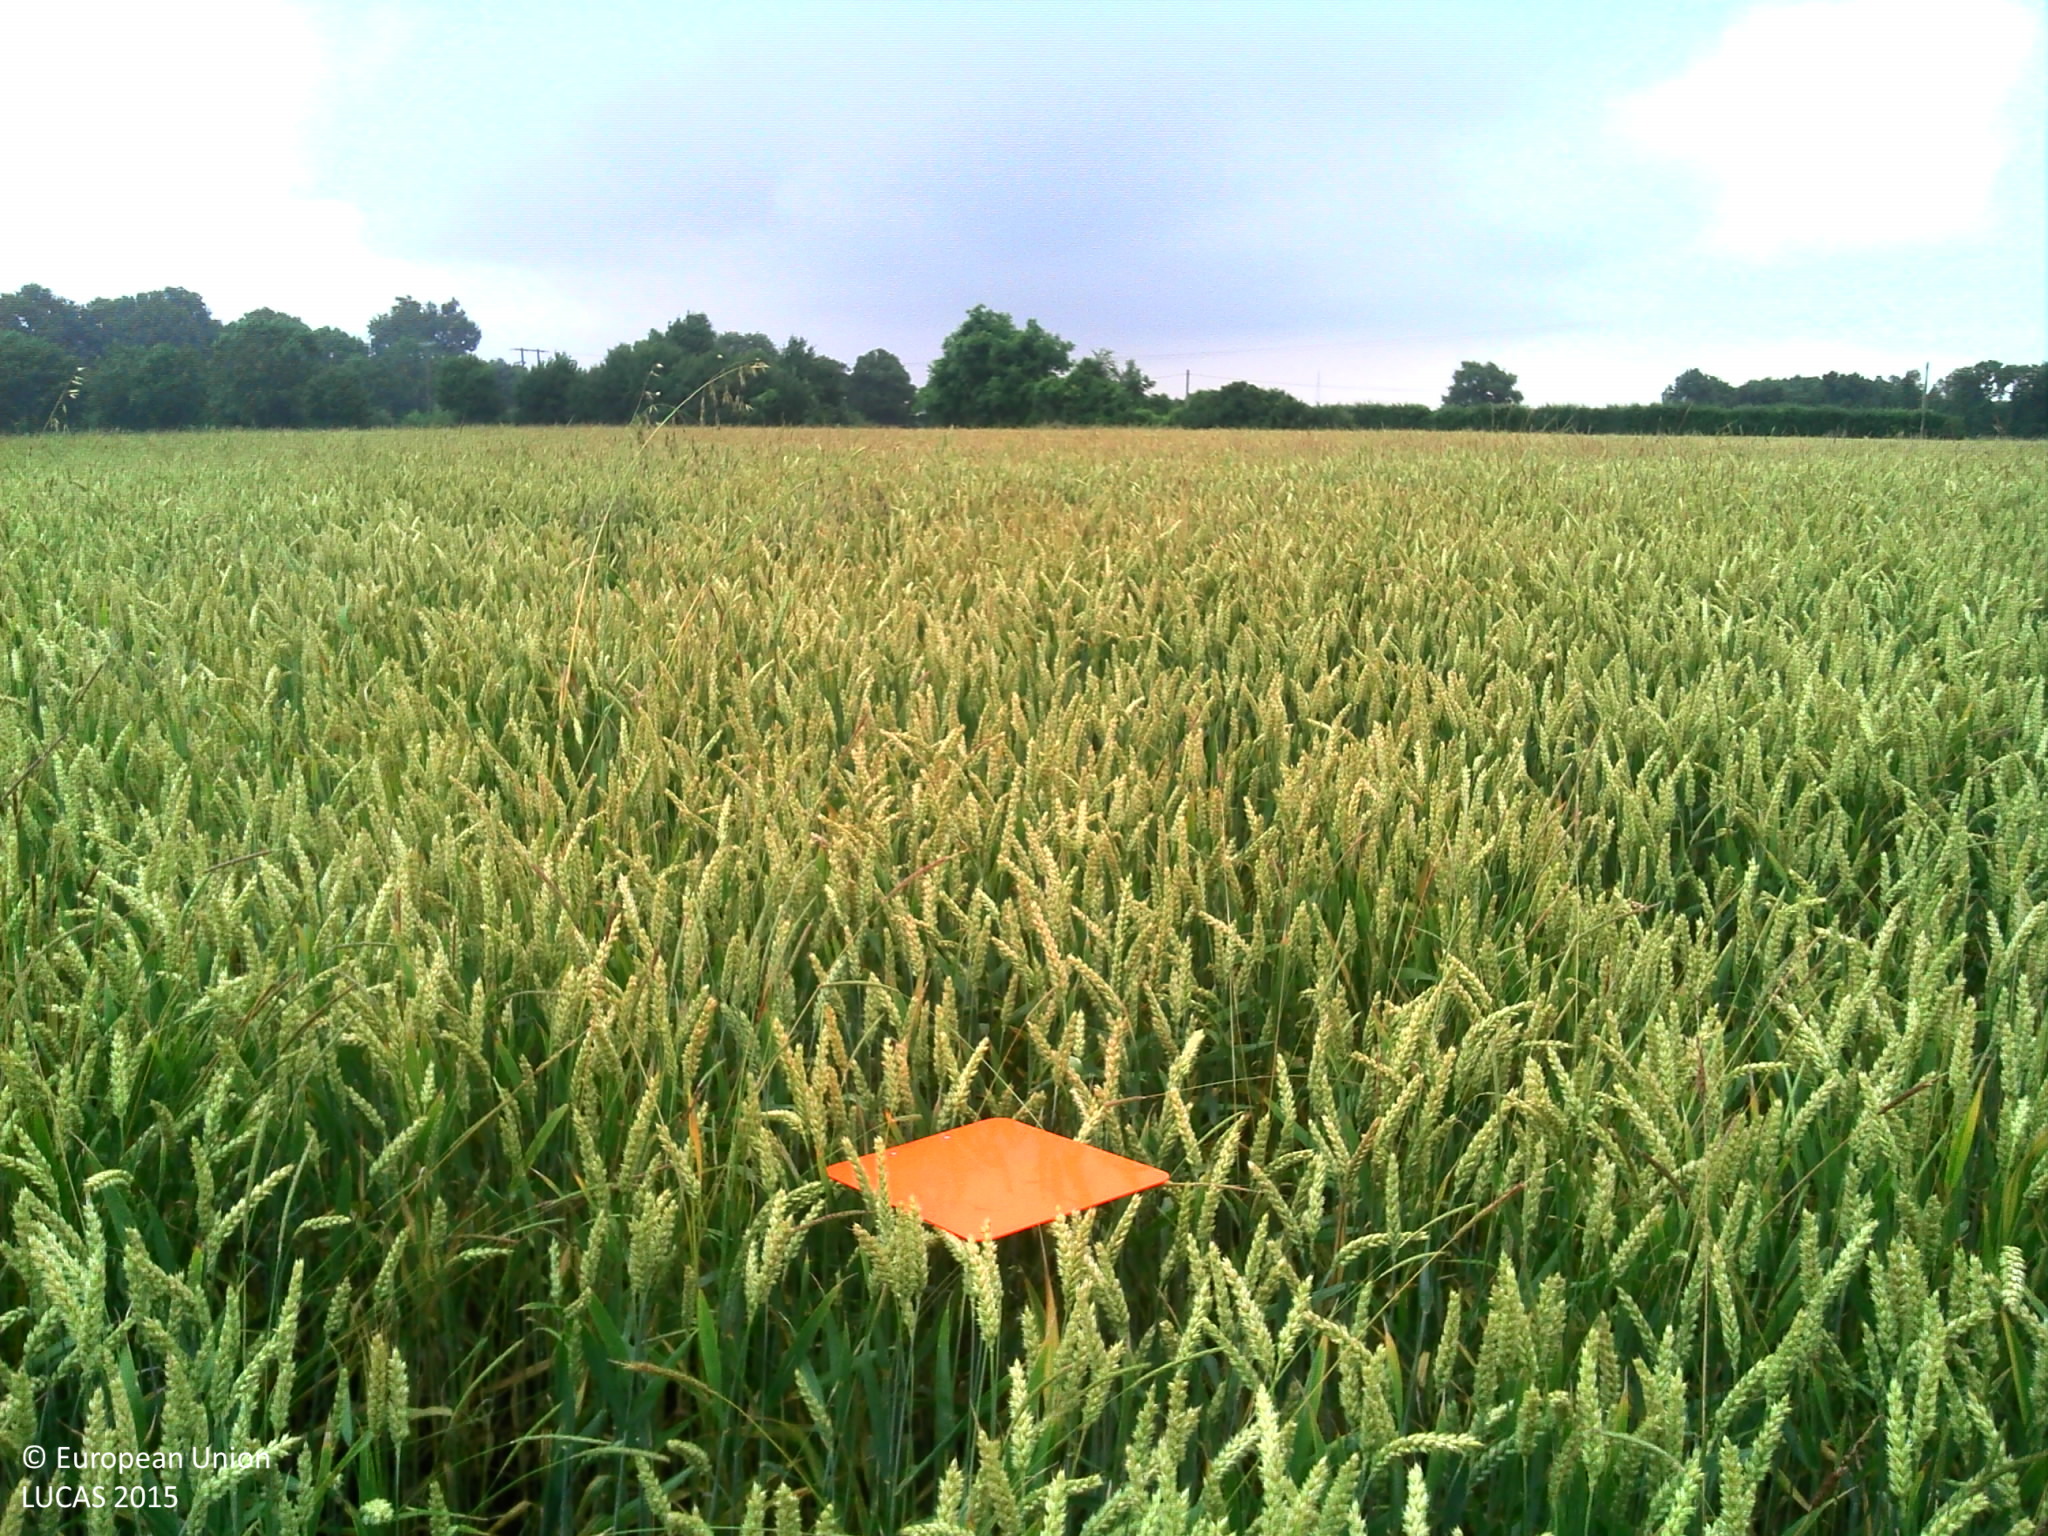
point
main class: Cropland
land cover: Common wheat
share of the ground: > 75 %
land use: Agriculture (excluding fallow land and kitchen gardens)
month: June
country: FR
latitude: 45.9152
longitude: -0.7660
